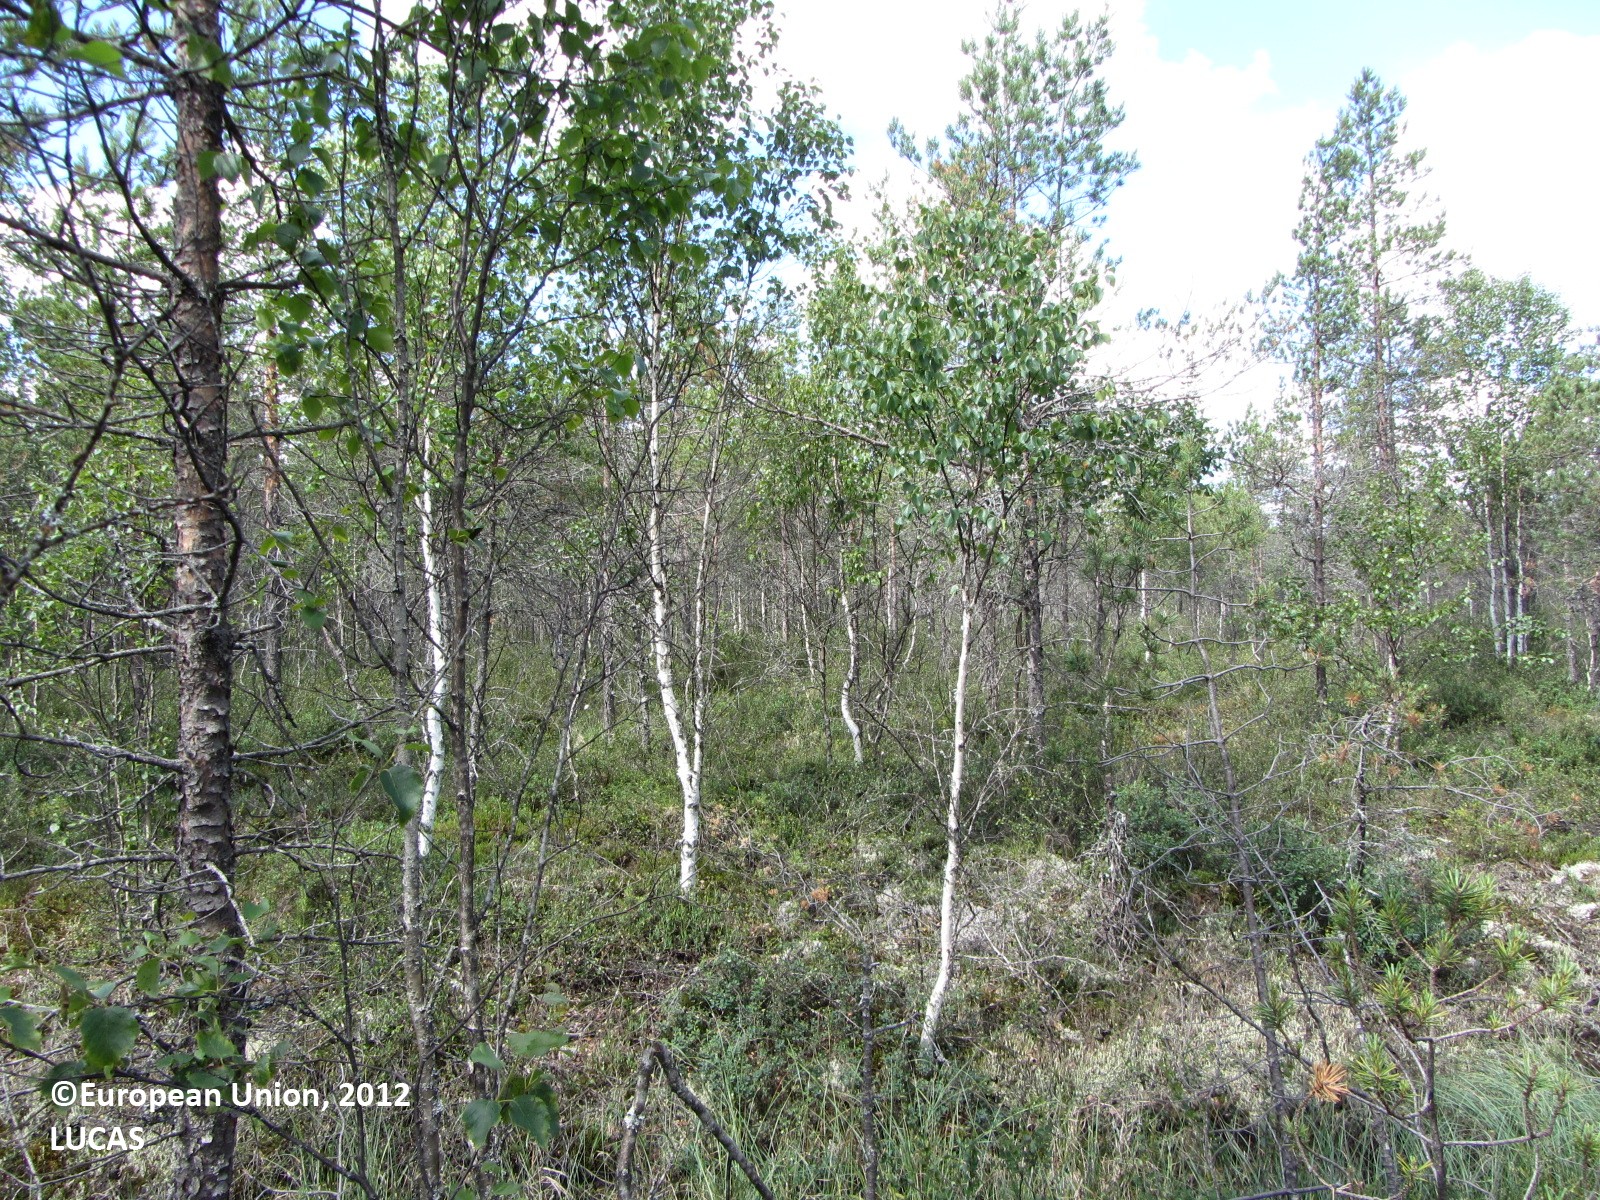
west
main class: Woodland
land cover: Pine dominated coniferous woodland
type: boreal forest
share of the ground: 50 - 75 %
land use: Forestry
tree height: > 5 m
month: July
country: FI
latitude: 63.6866
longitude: 25.4863
